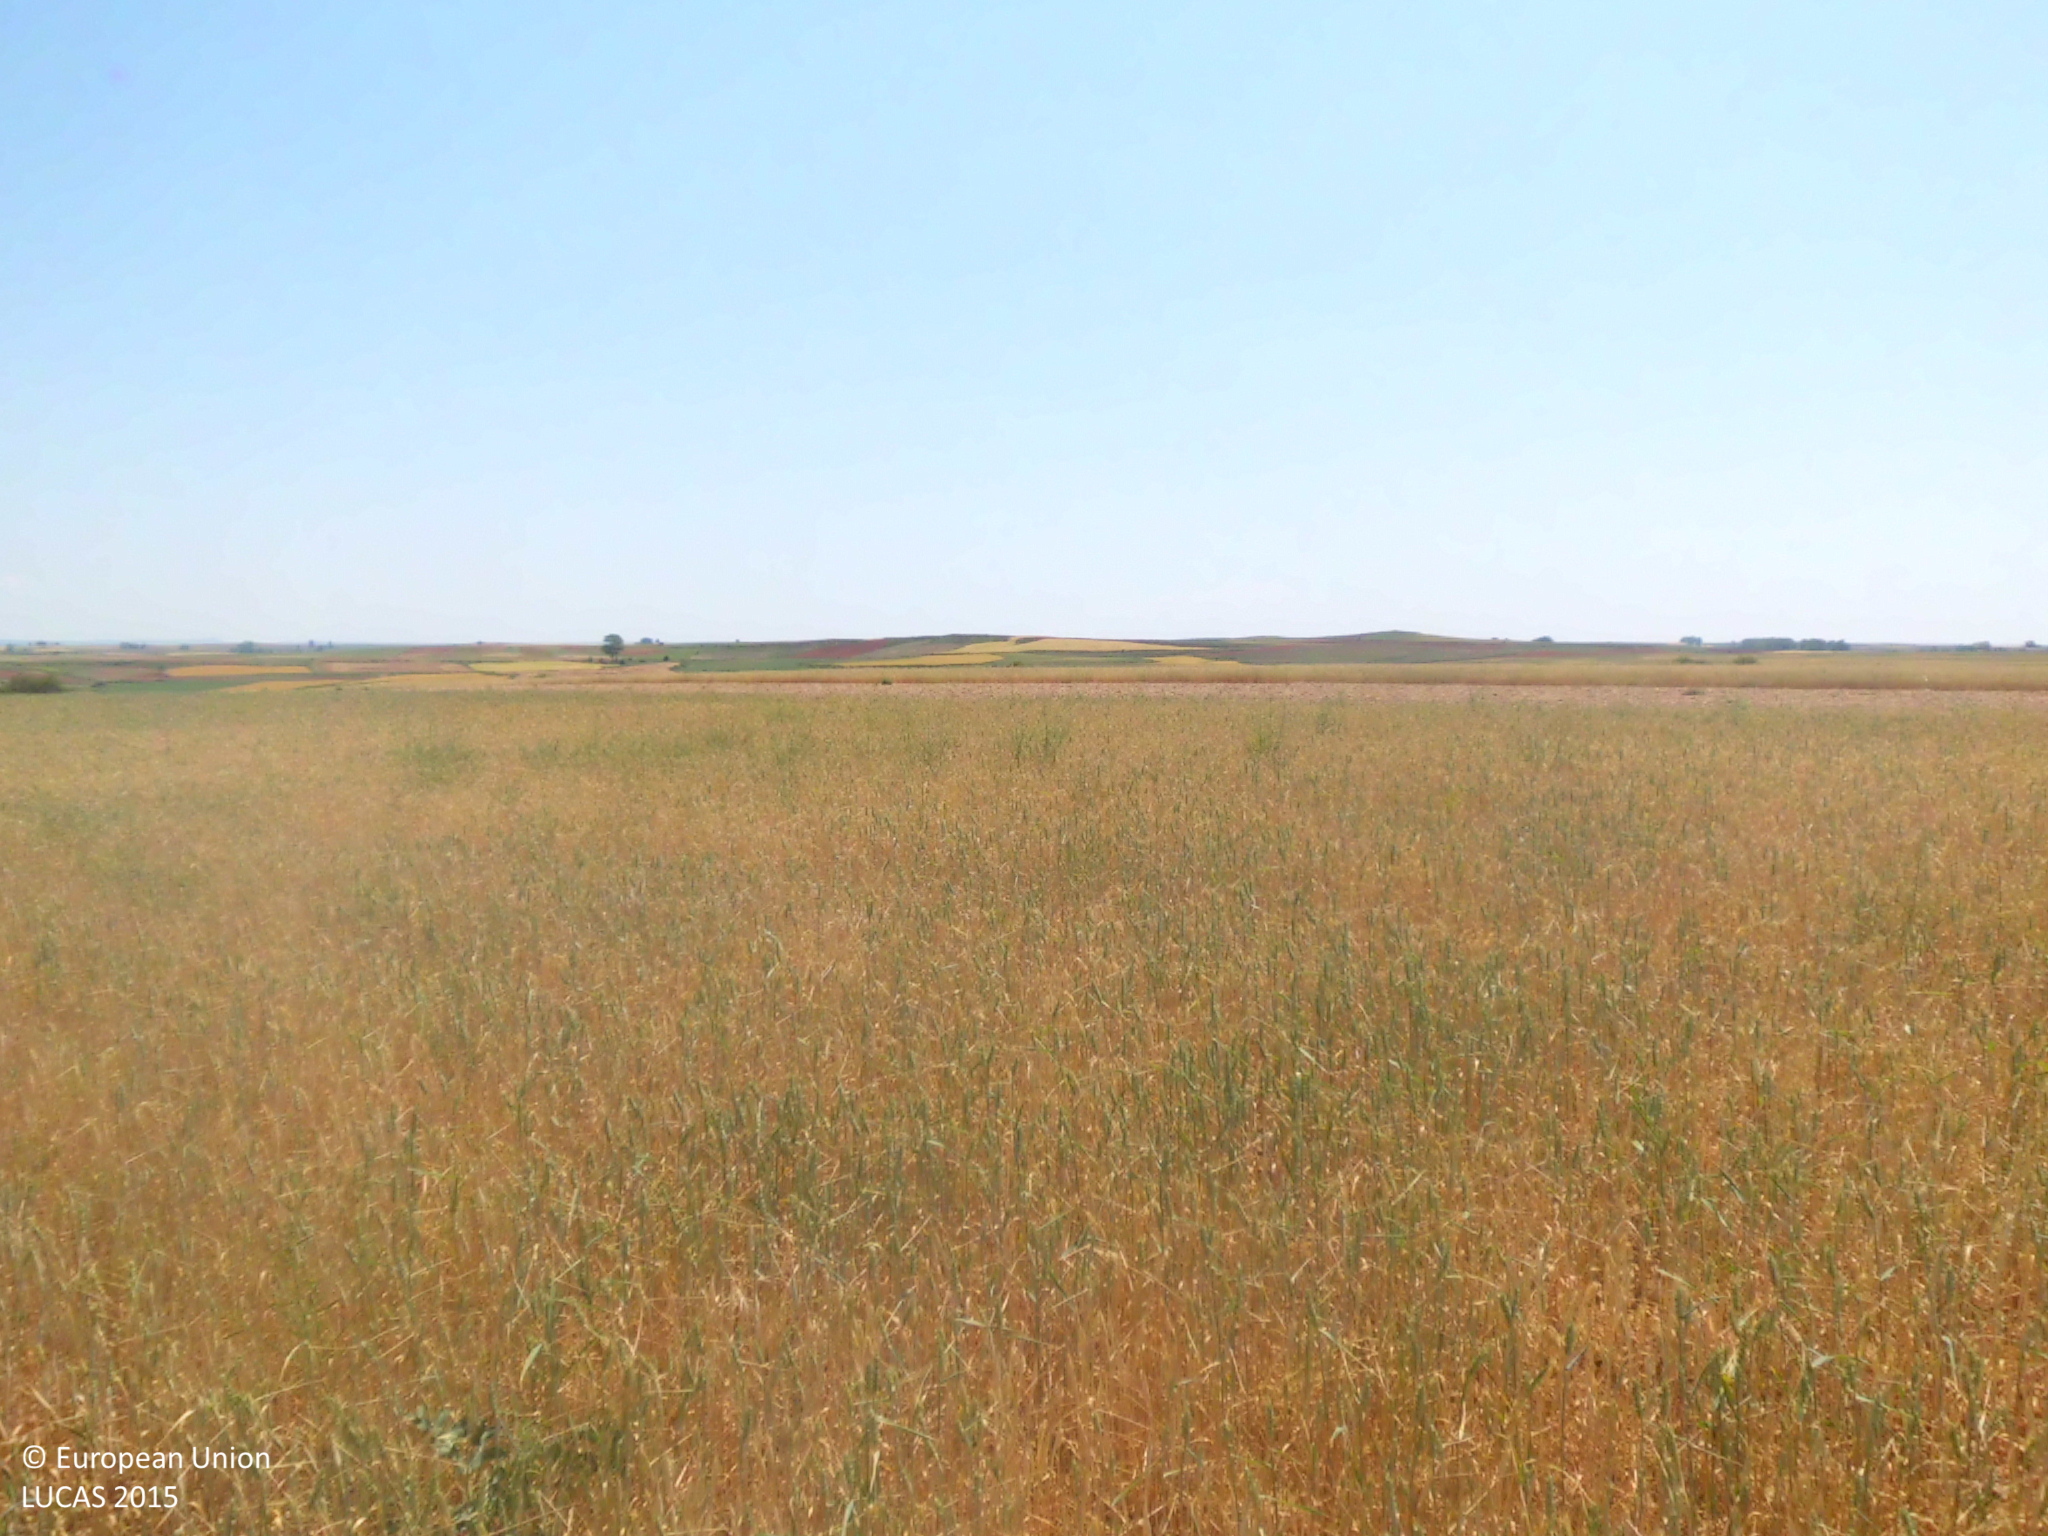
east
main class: Cropland
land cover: Common wheat
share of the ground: > 75 %
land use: Agriculture (excluding fallow land and kitchen gardens)
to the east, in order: Common wheat; Other bare soil; Oats; Grassland without tree/shrub cover; Mixed cereals for fodder; Grass margins; Common wheat; Spontaneously vegetated surfaces; Barley; Other bare soil
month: June
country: ES
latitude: 42.5048
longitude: -4.2238
